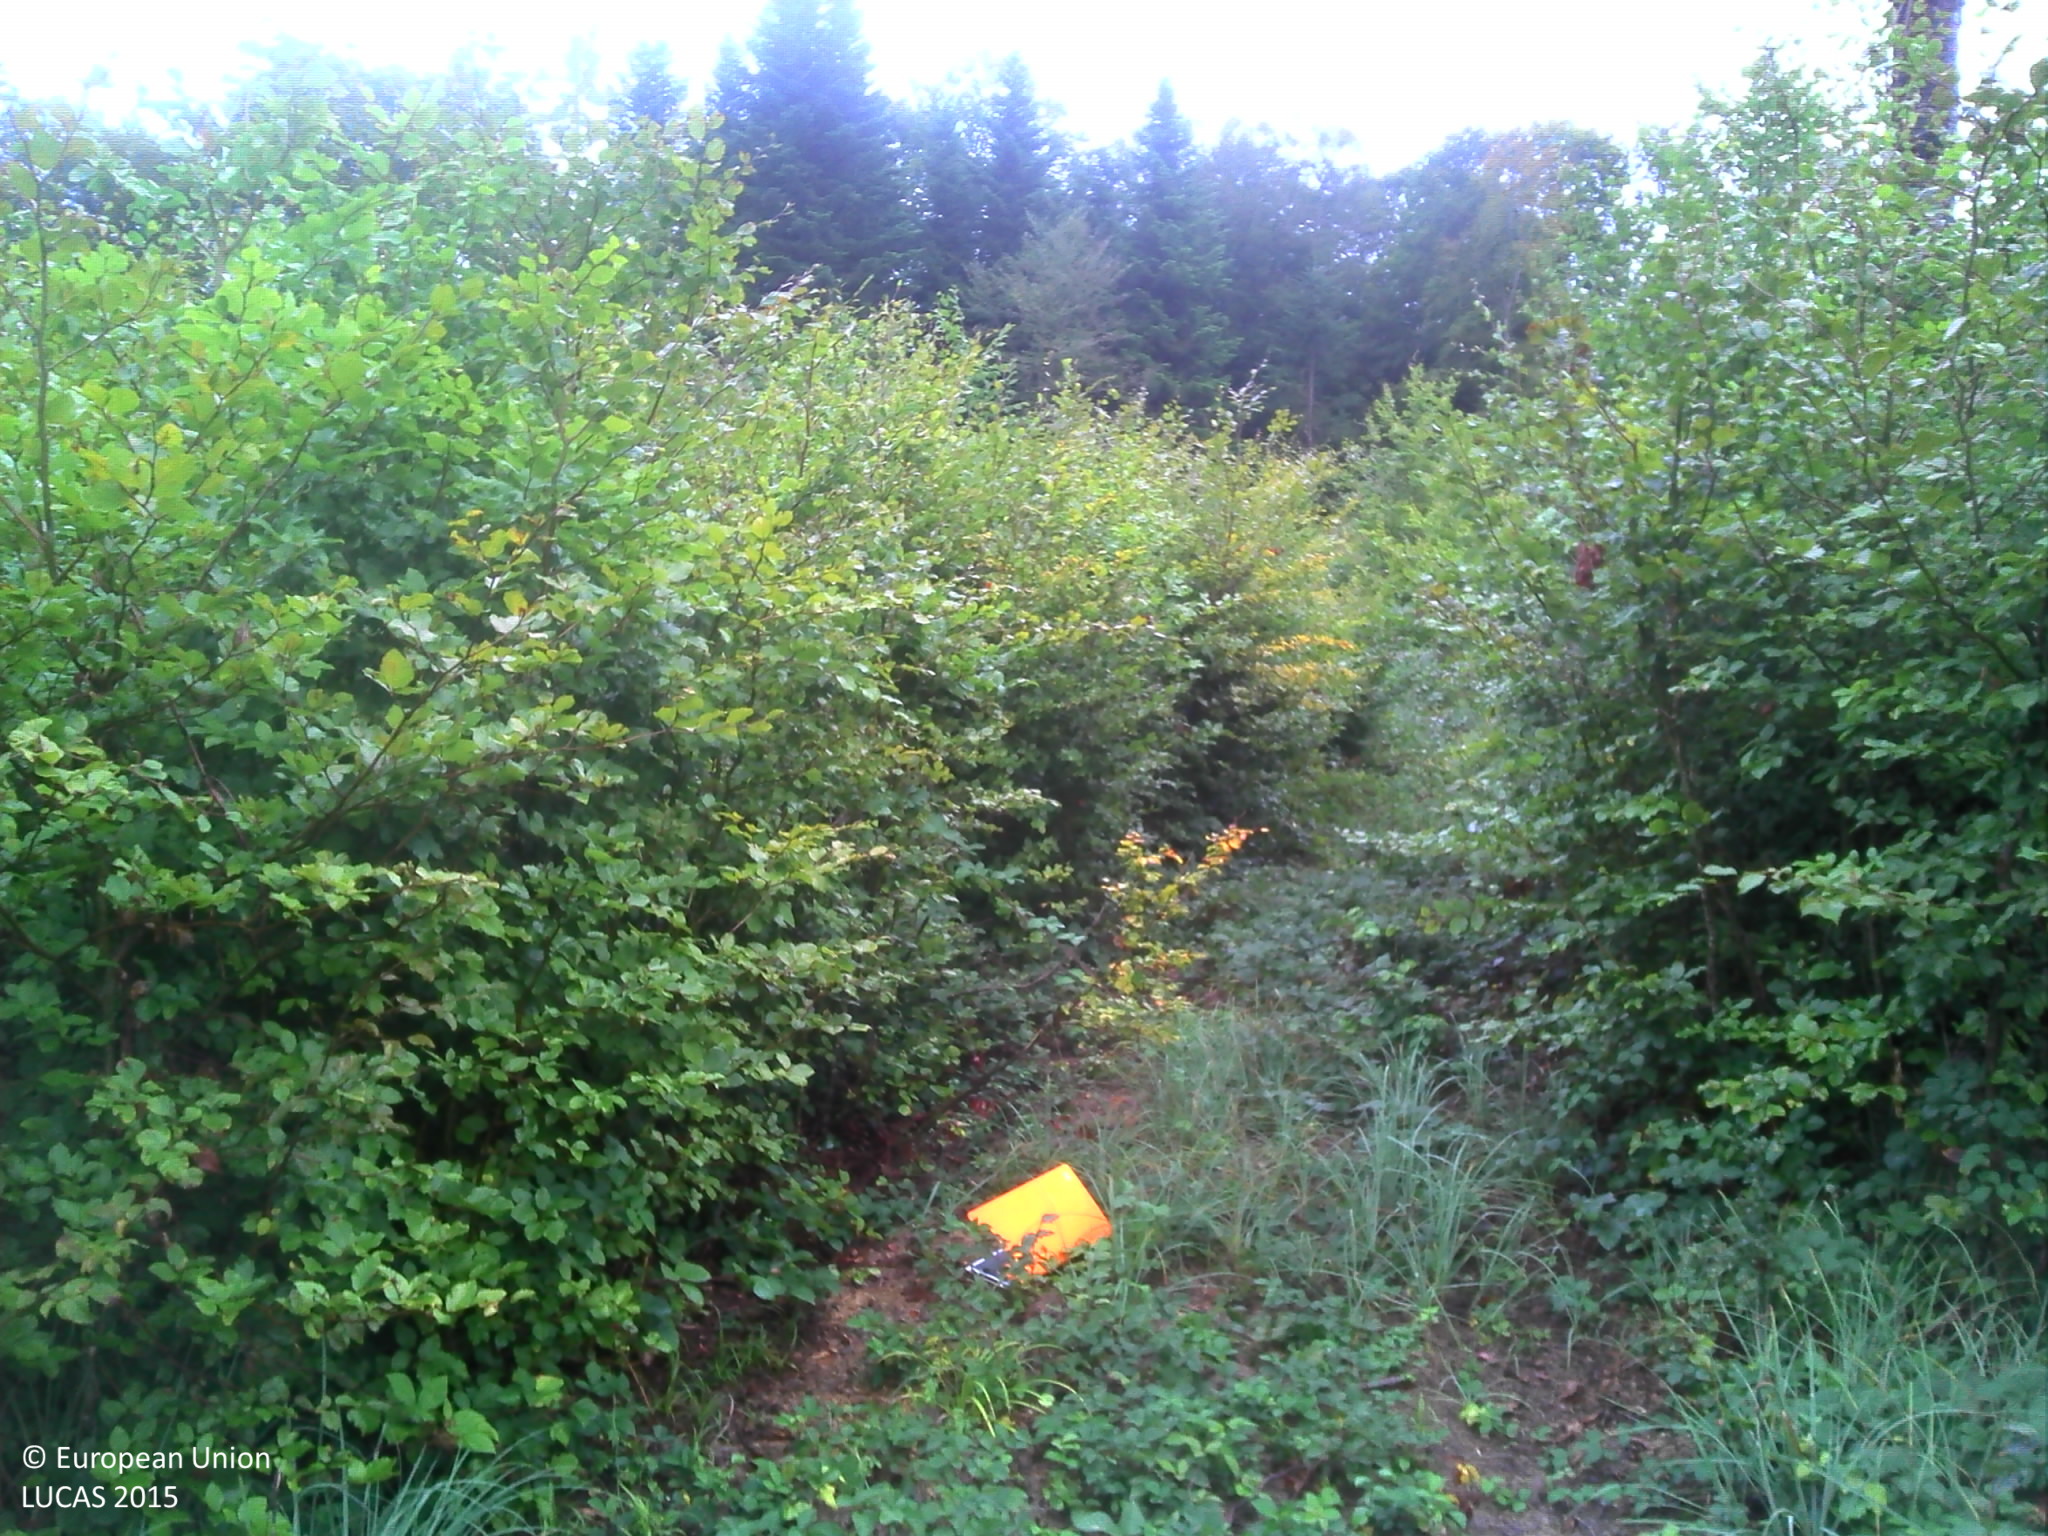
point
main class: Woodland
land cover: Broadleaved woodland
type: mesophytic deciduous forest
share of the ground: > 75 %
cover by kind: broadleaved forest trees 60 %, shrubs 20 %, herbaceous plants 10 %, consolidated bare surface 10 %
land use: Forestry
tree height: < 5 m
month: September
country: FR
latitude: 47.1694
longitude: 6.2684
